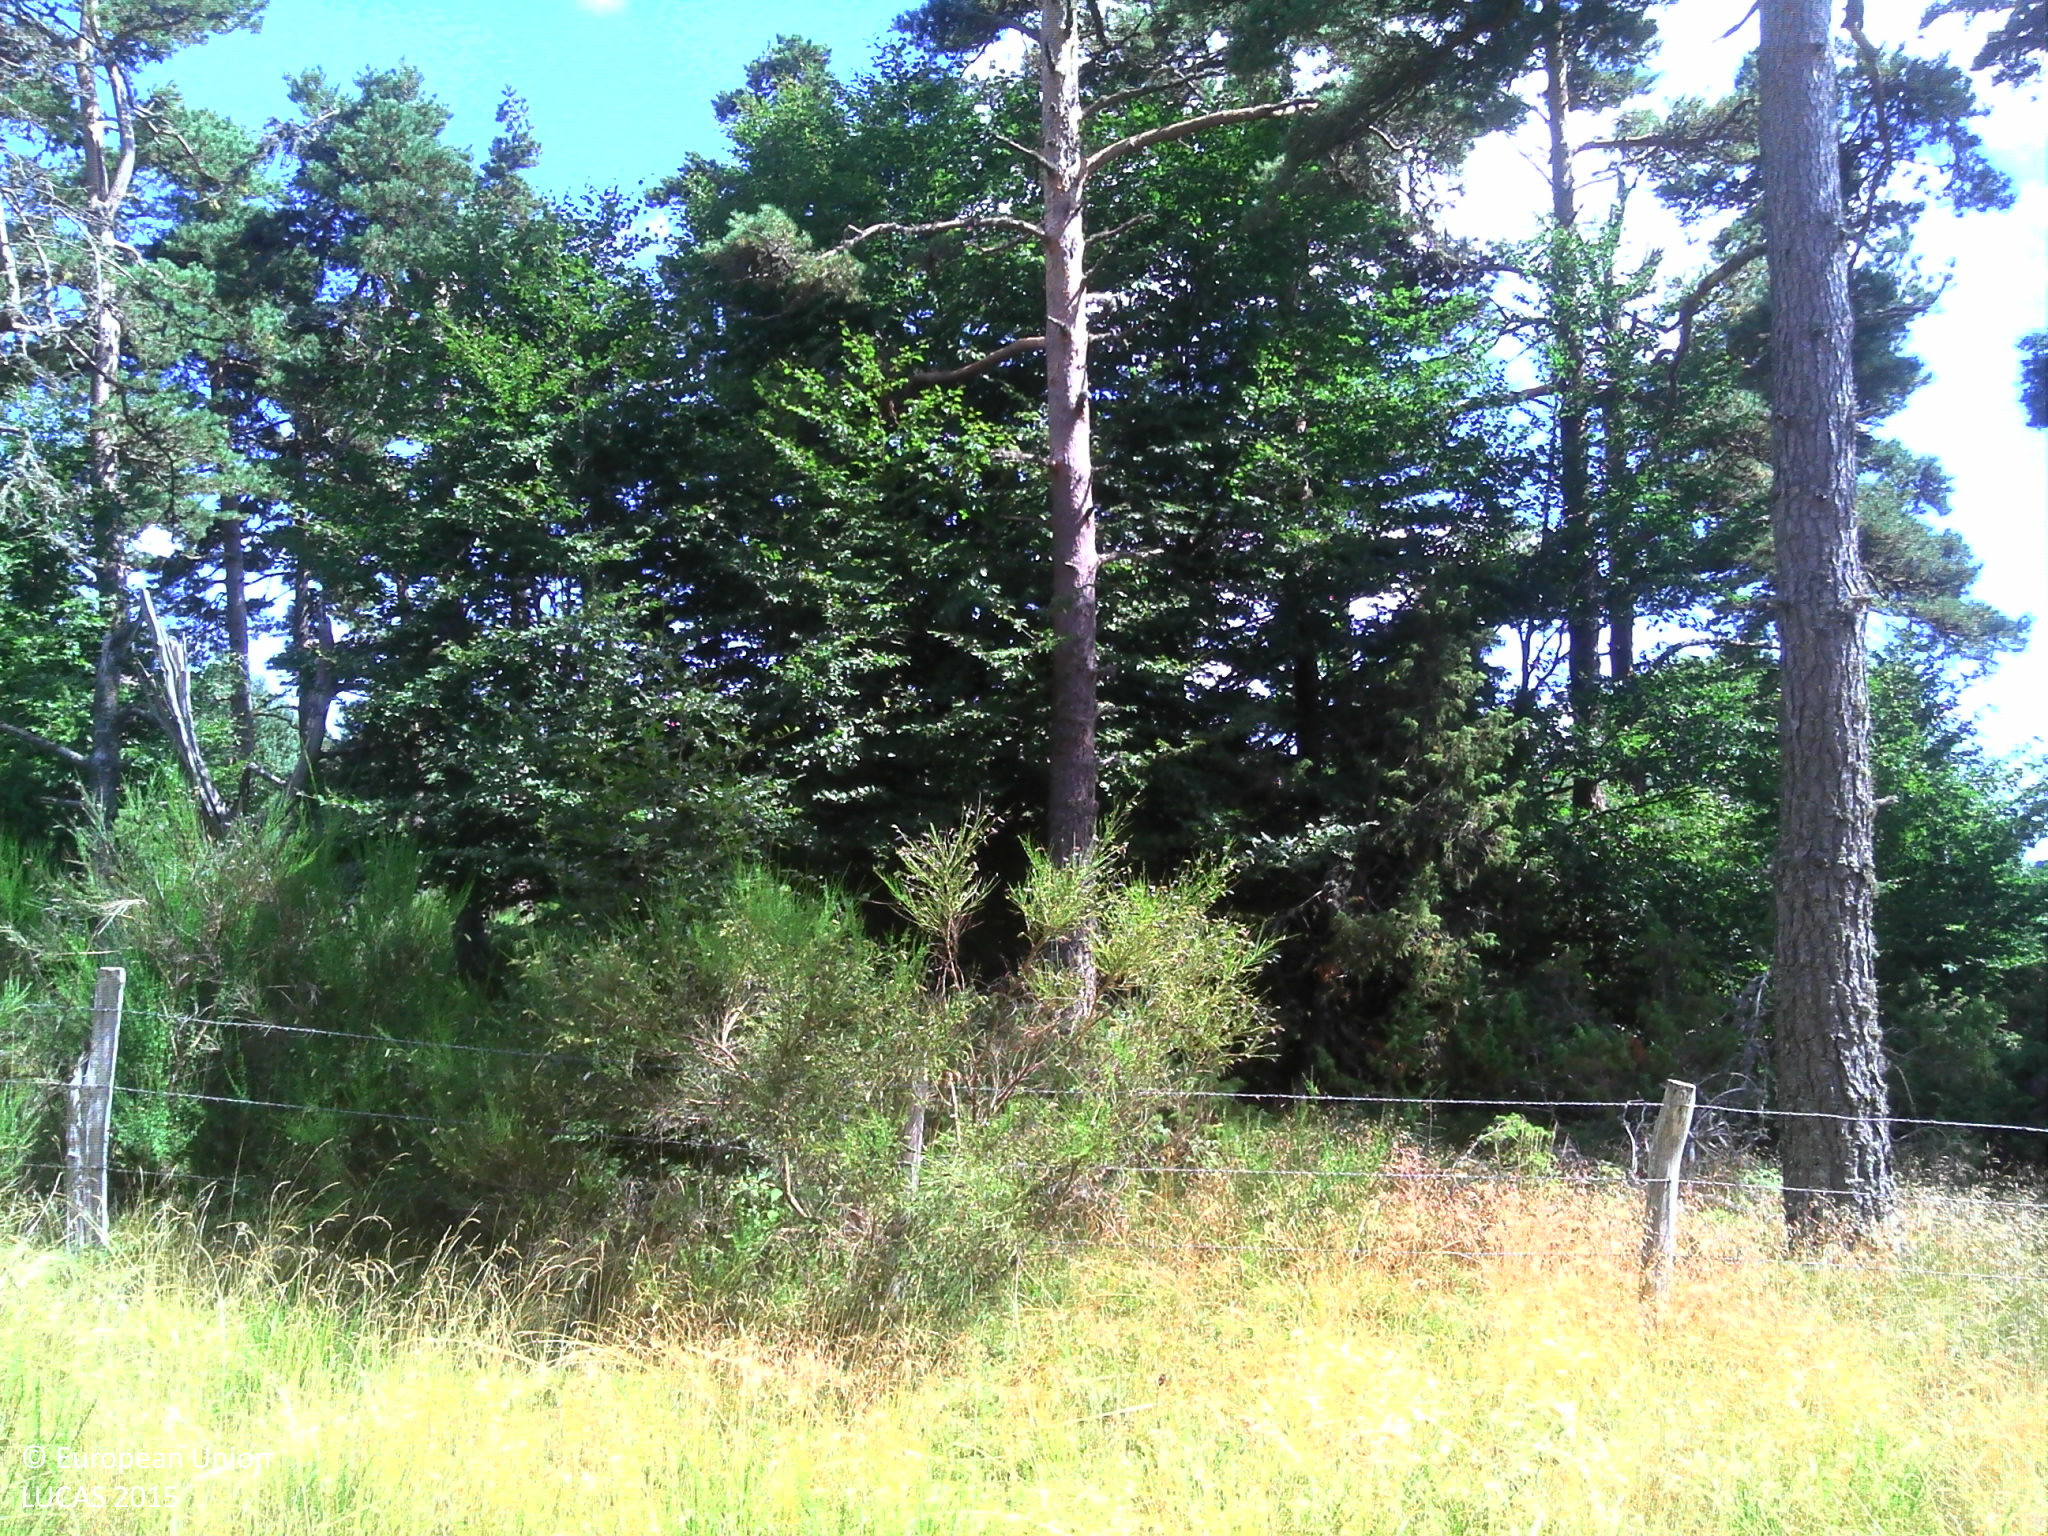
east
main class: Grassland
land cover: Grassland without tree/shrub cover
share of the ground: > 75 %
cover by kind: herbaceous plants 95 %, shrubs 5 %
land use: Agriculture (excluding fallow land and kitchen gardens)
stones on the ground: 10 - 25 %
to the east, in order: Grassland without tree/shrub cover; Fences; Tracks; Pine dominated coniferous woodland
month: July
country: FR
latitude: 44.7945
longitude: 3.1647
